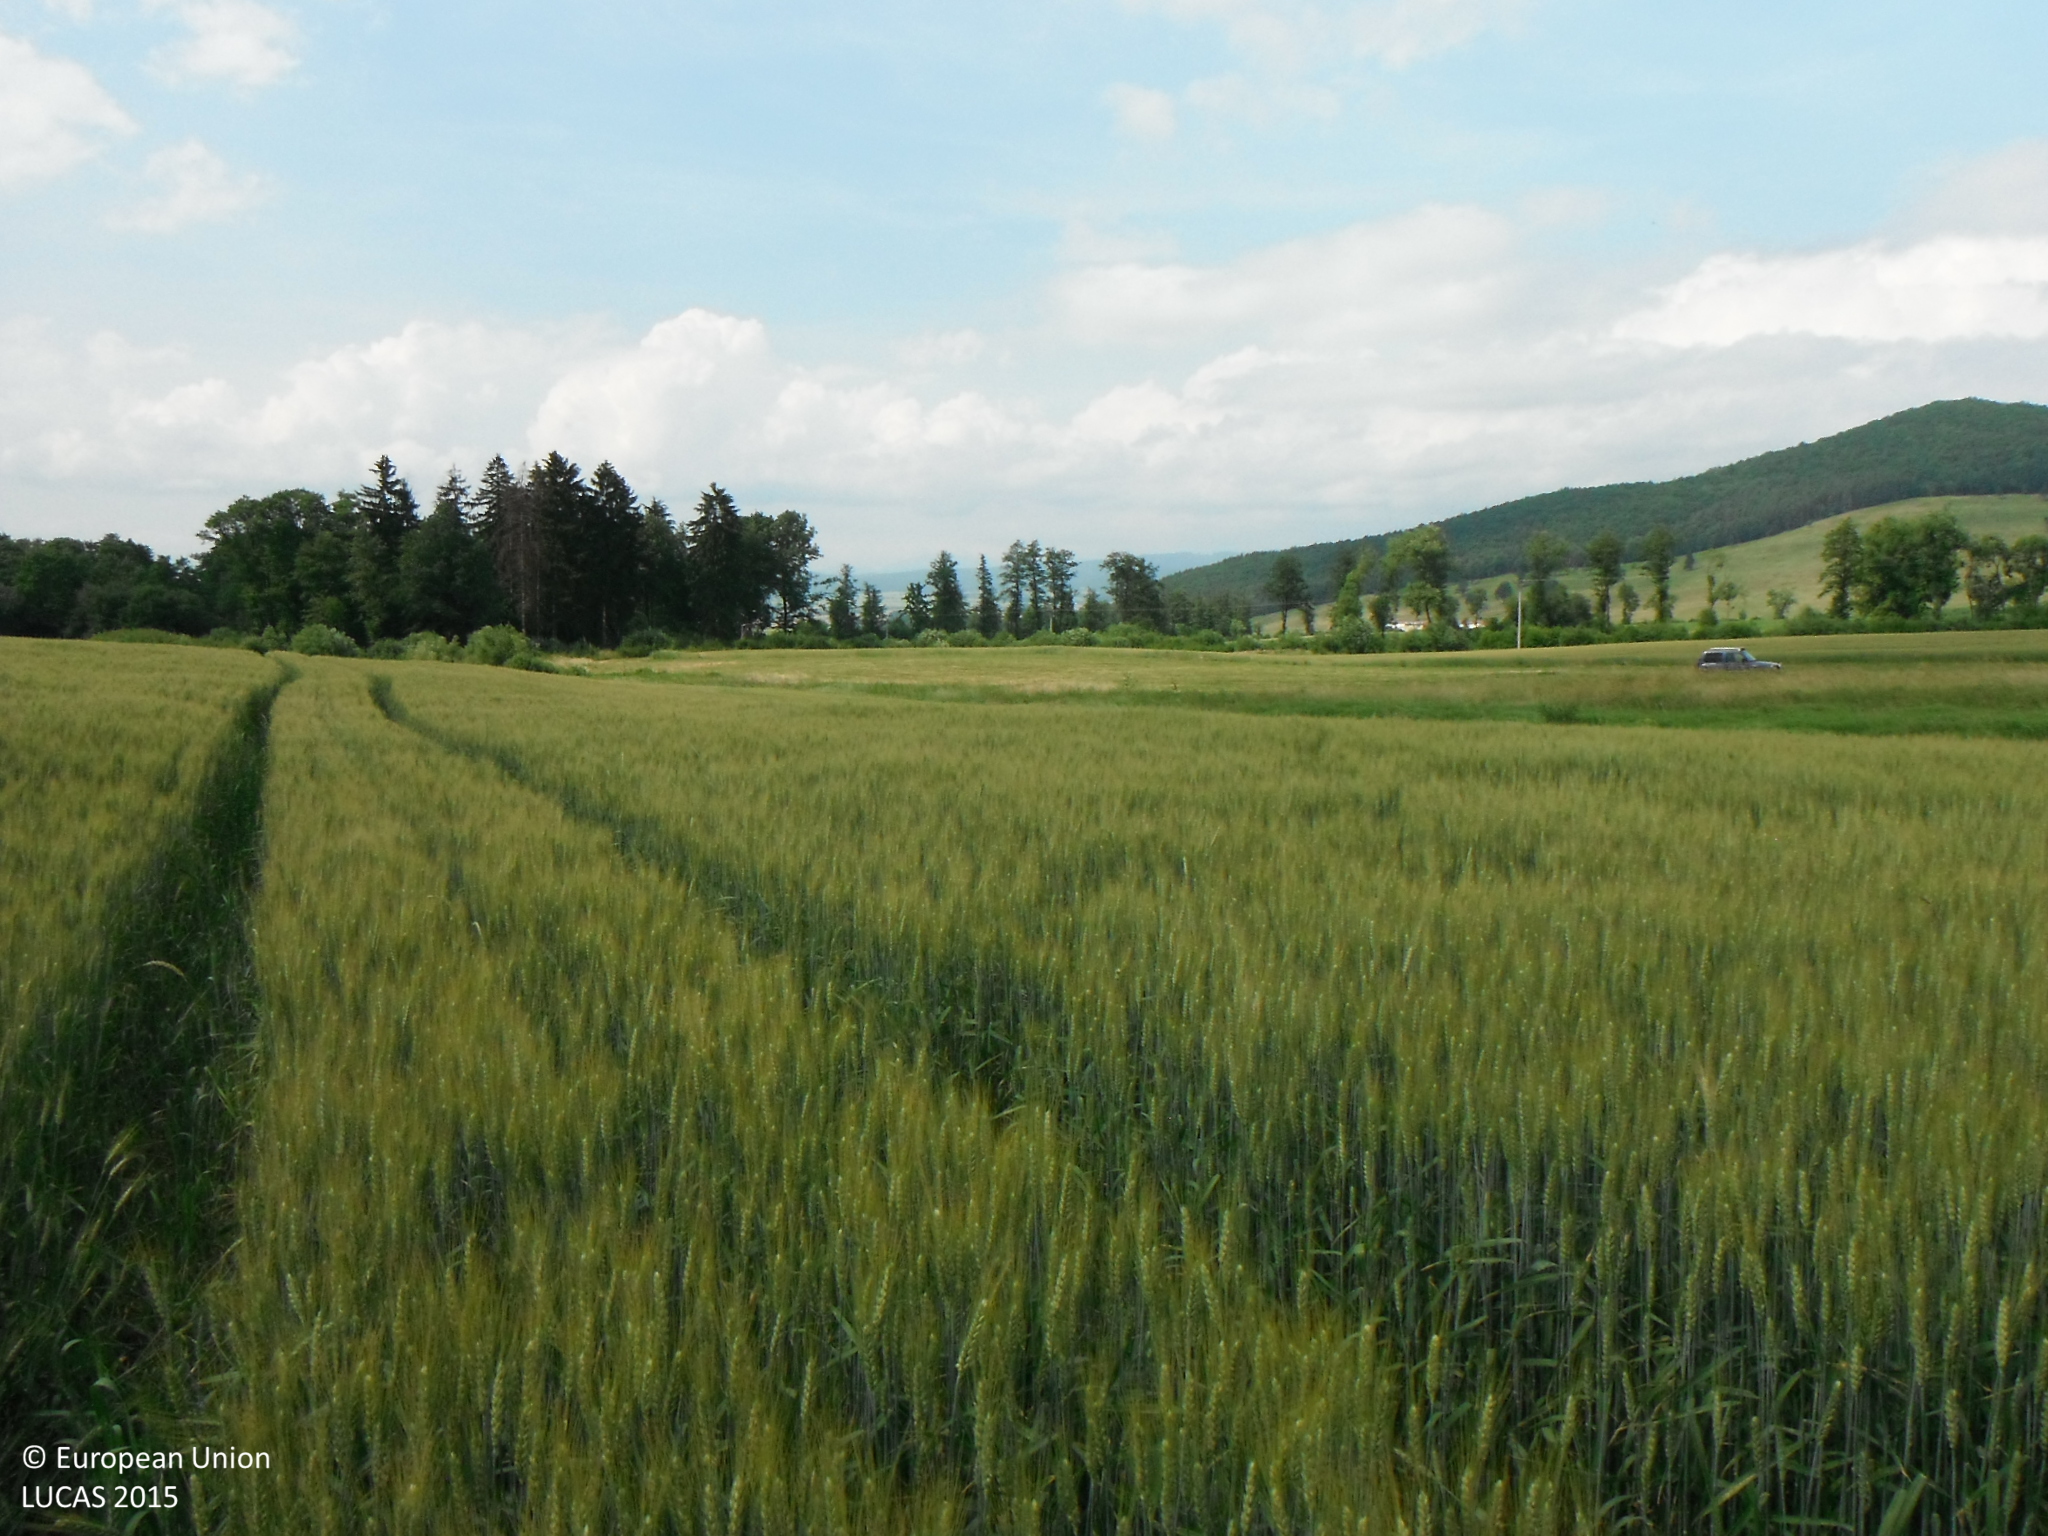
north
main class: Cropland
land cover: Common wheat
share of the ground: > 75 %
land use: Agriculture (excluding fallow land and kitchen gardens)
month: June
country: SK
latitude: 48.5159
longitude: 19.3239
